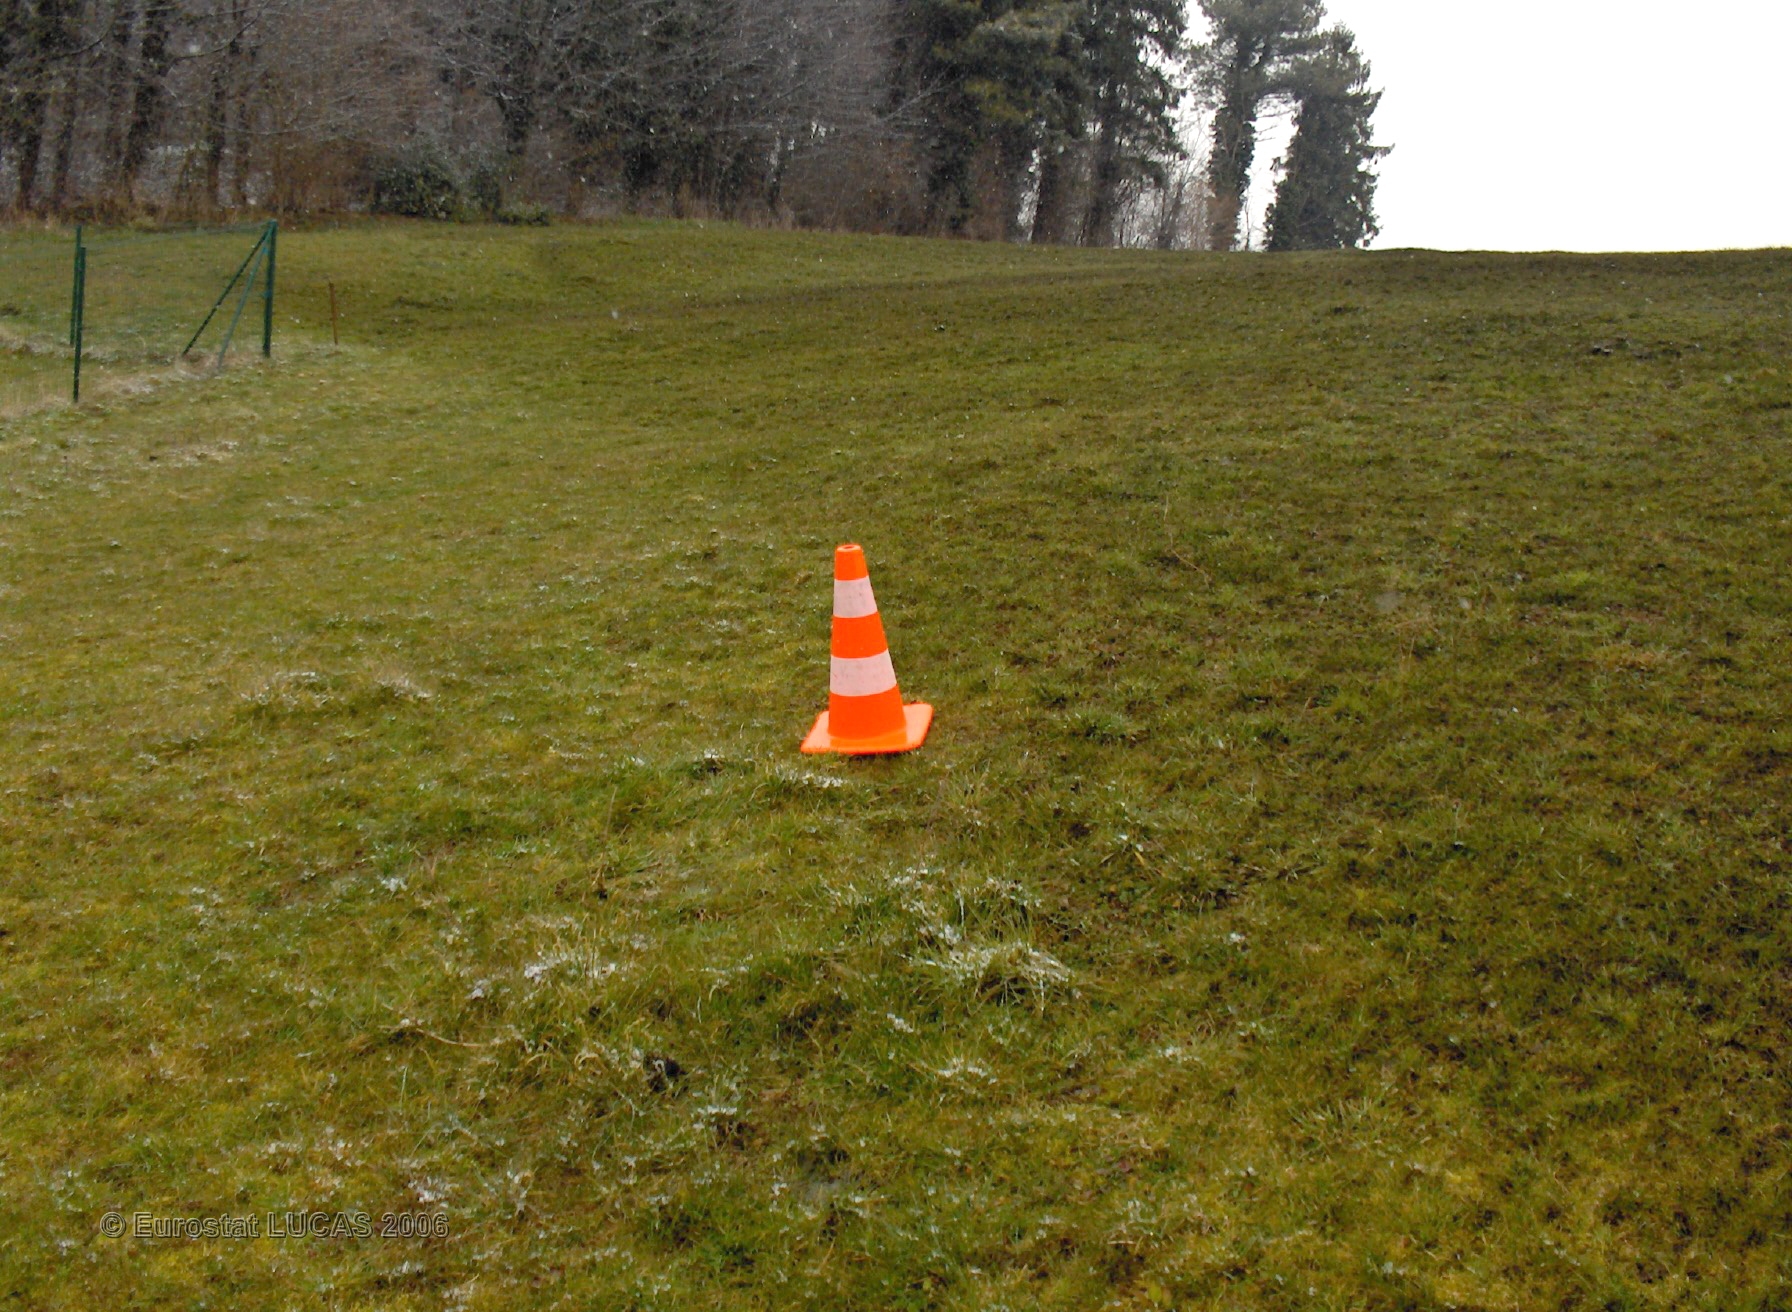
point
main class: Grassland
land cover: Grassland without tree/shrub cover
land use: Agriculture (excluding fallow land and kitchen gardens)
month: March
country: BE
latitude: 50.5162
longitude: 5.2167
